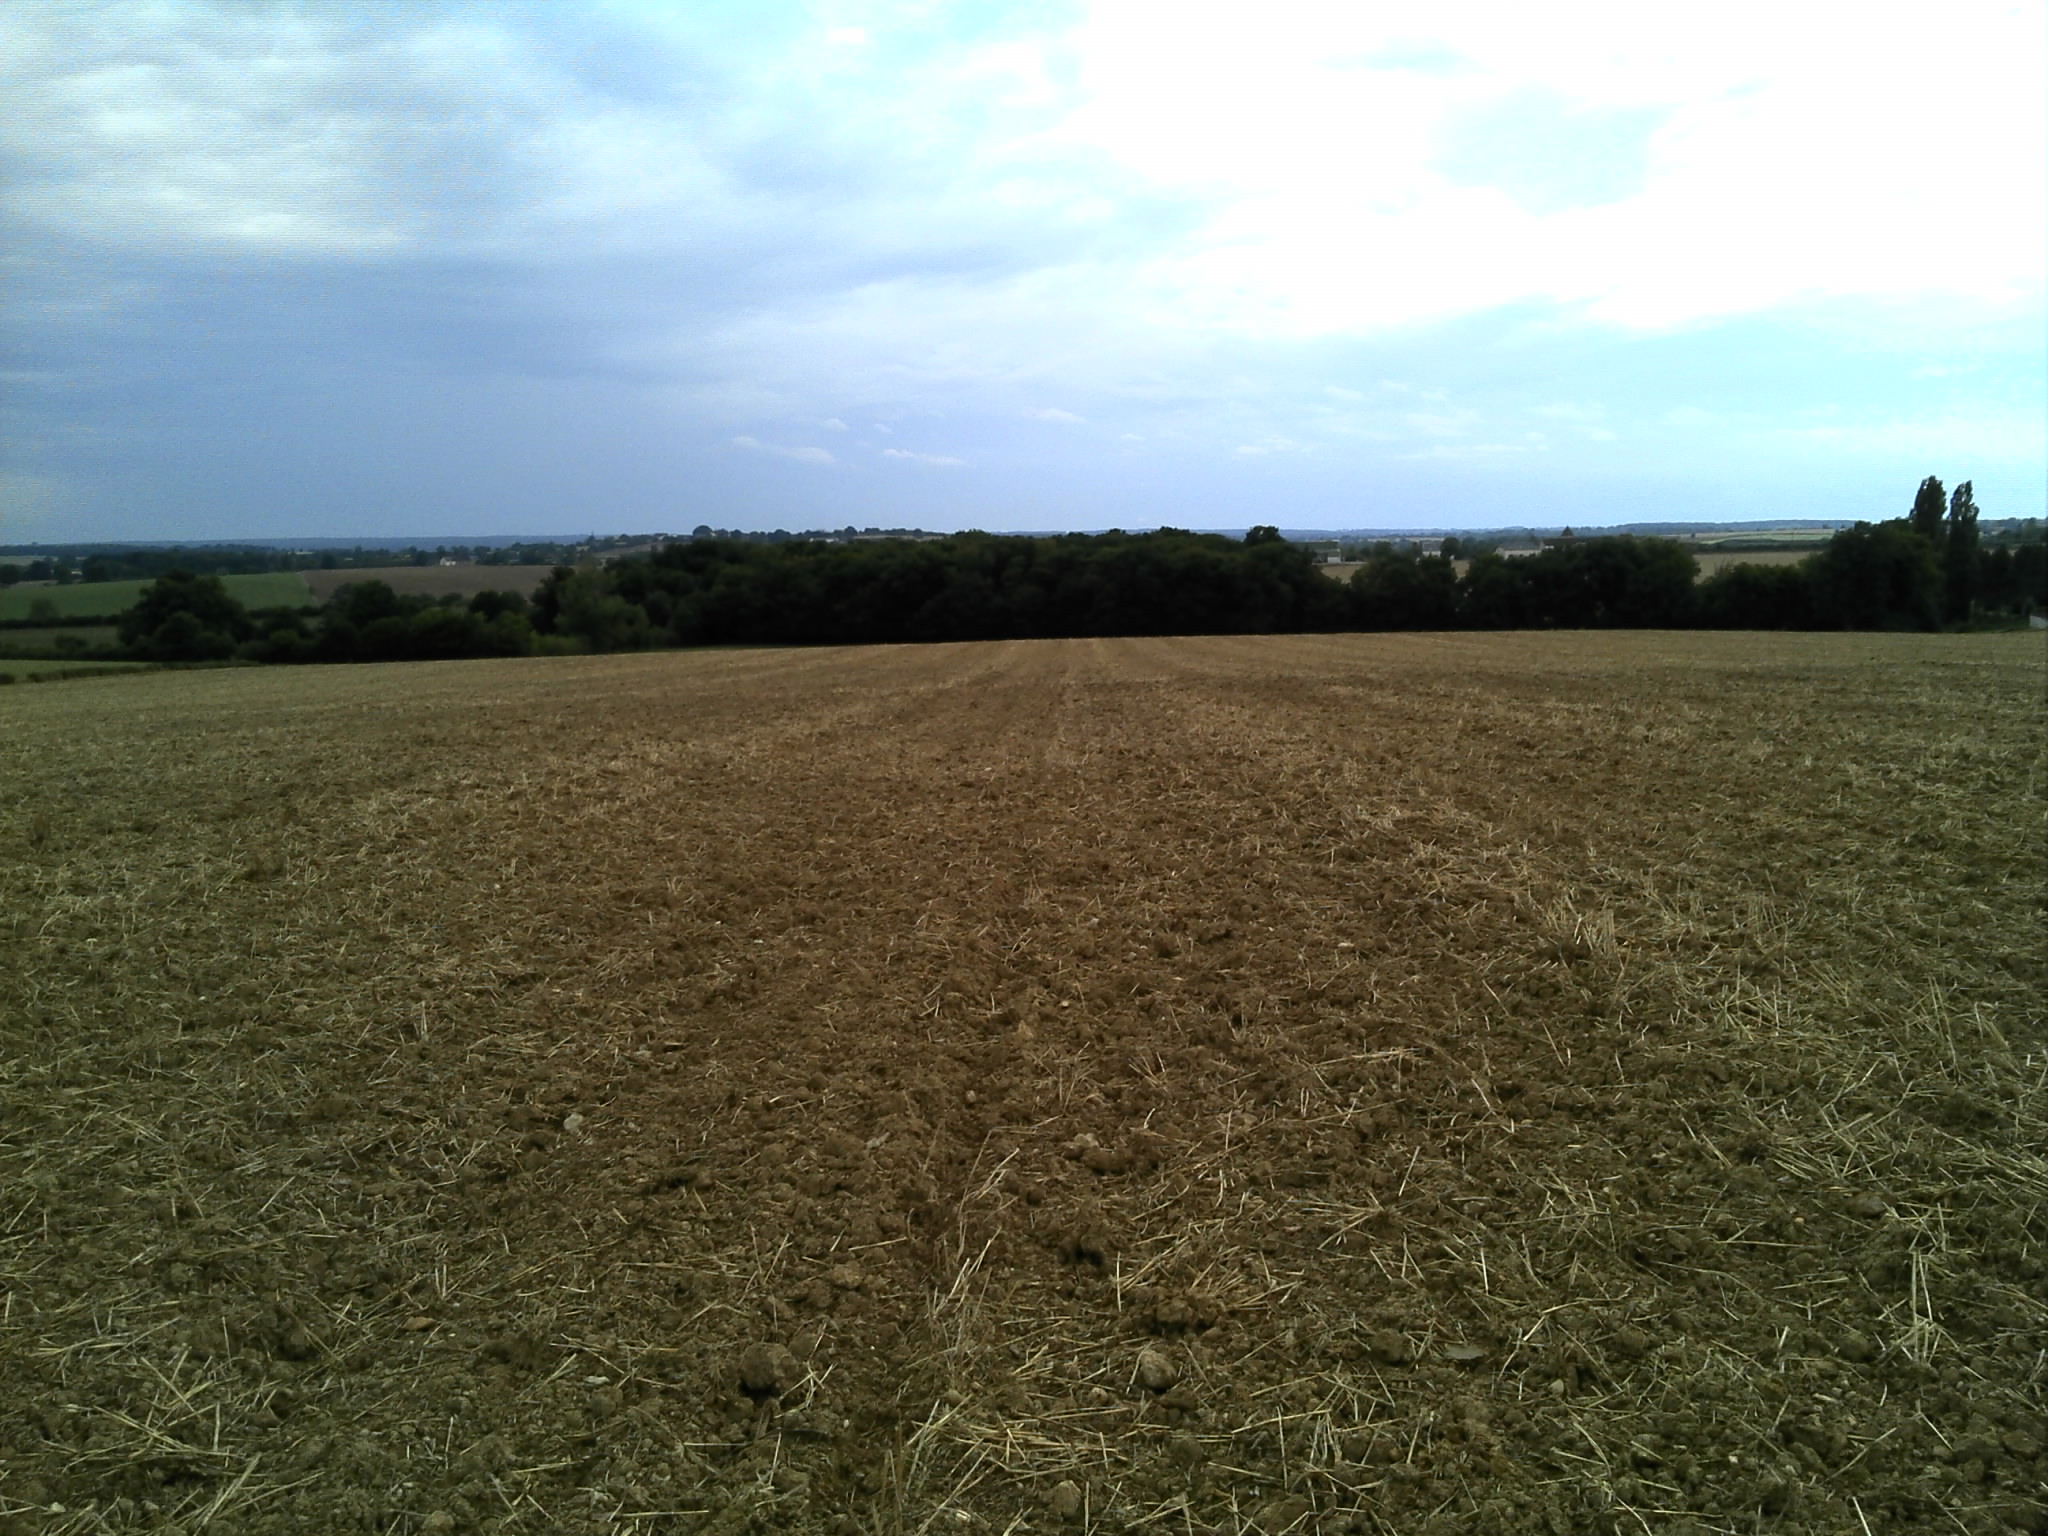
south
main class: Cropland
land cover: Common wheat
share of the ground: > 75 %
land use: Agriculture (excluding fallow land and kitchen gardens)
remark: Tilled/Sowed
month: August
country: FR
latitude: 46.6247
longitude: 2.1700
